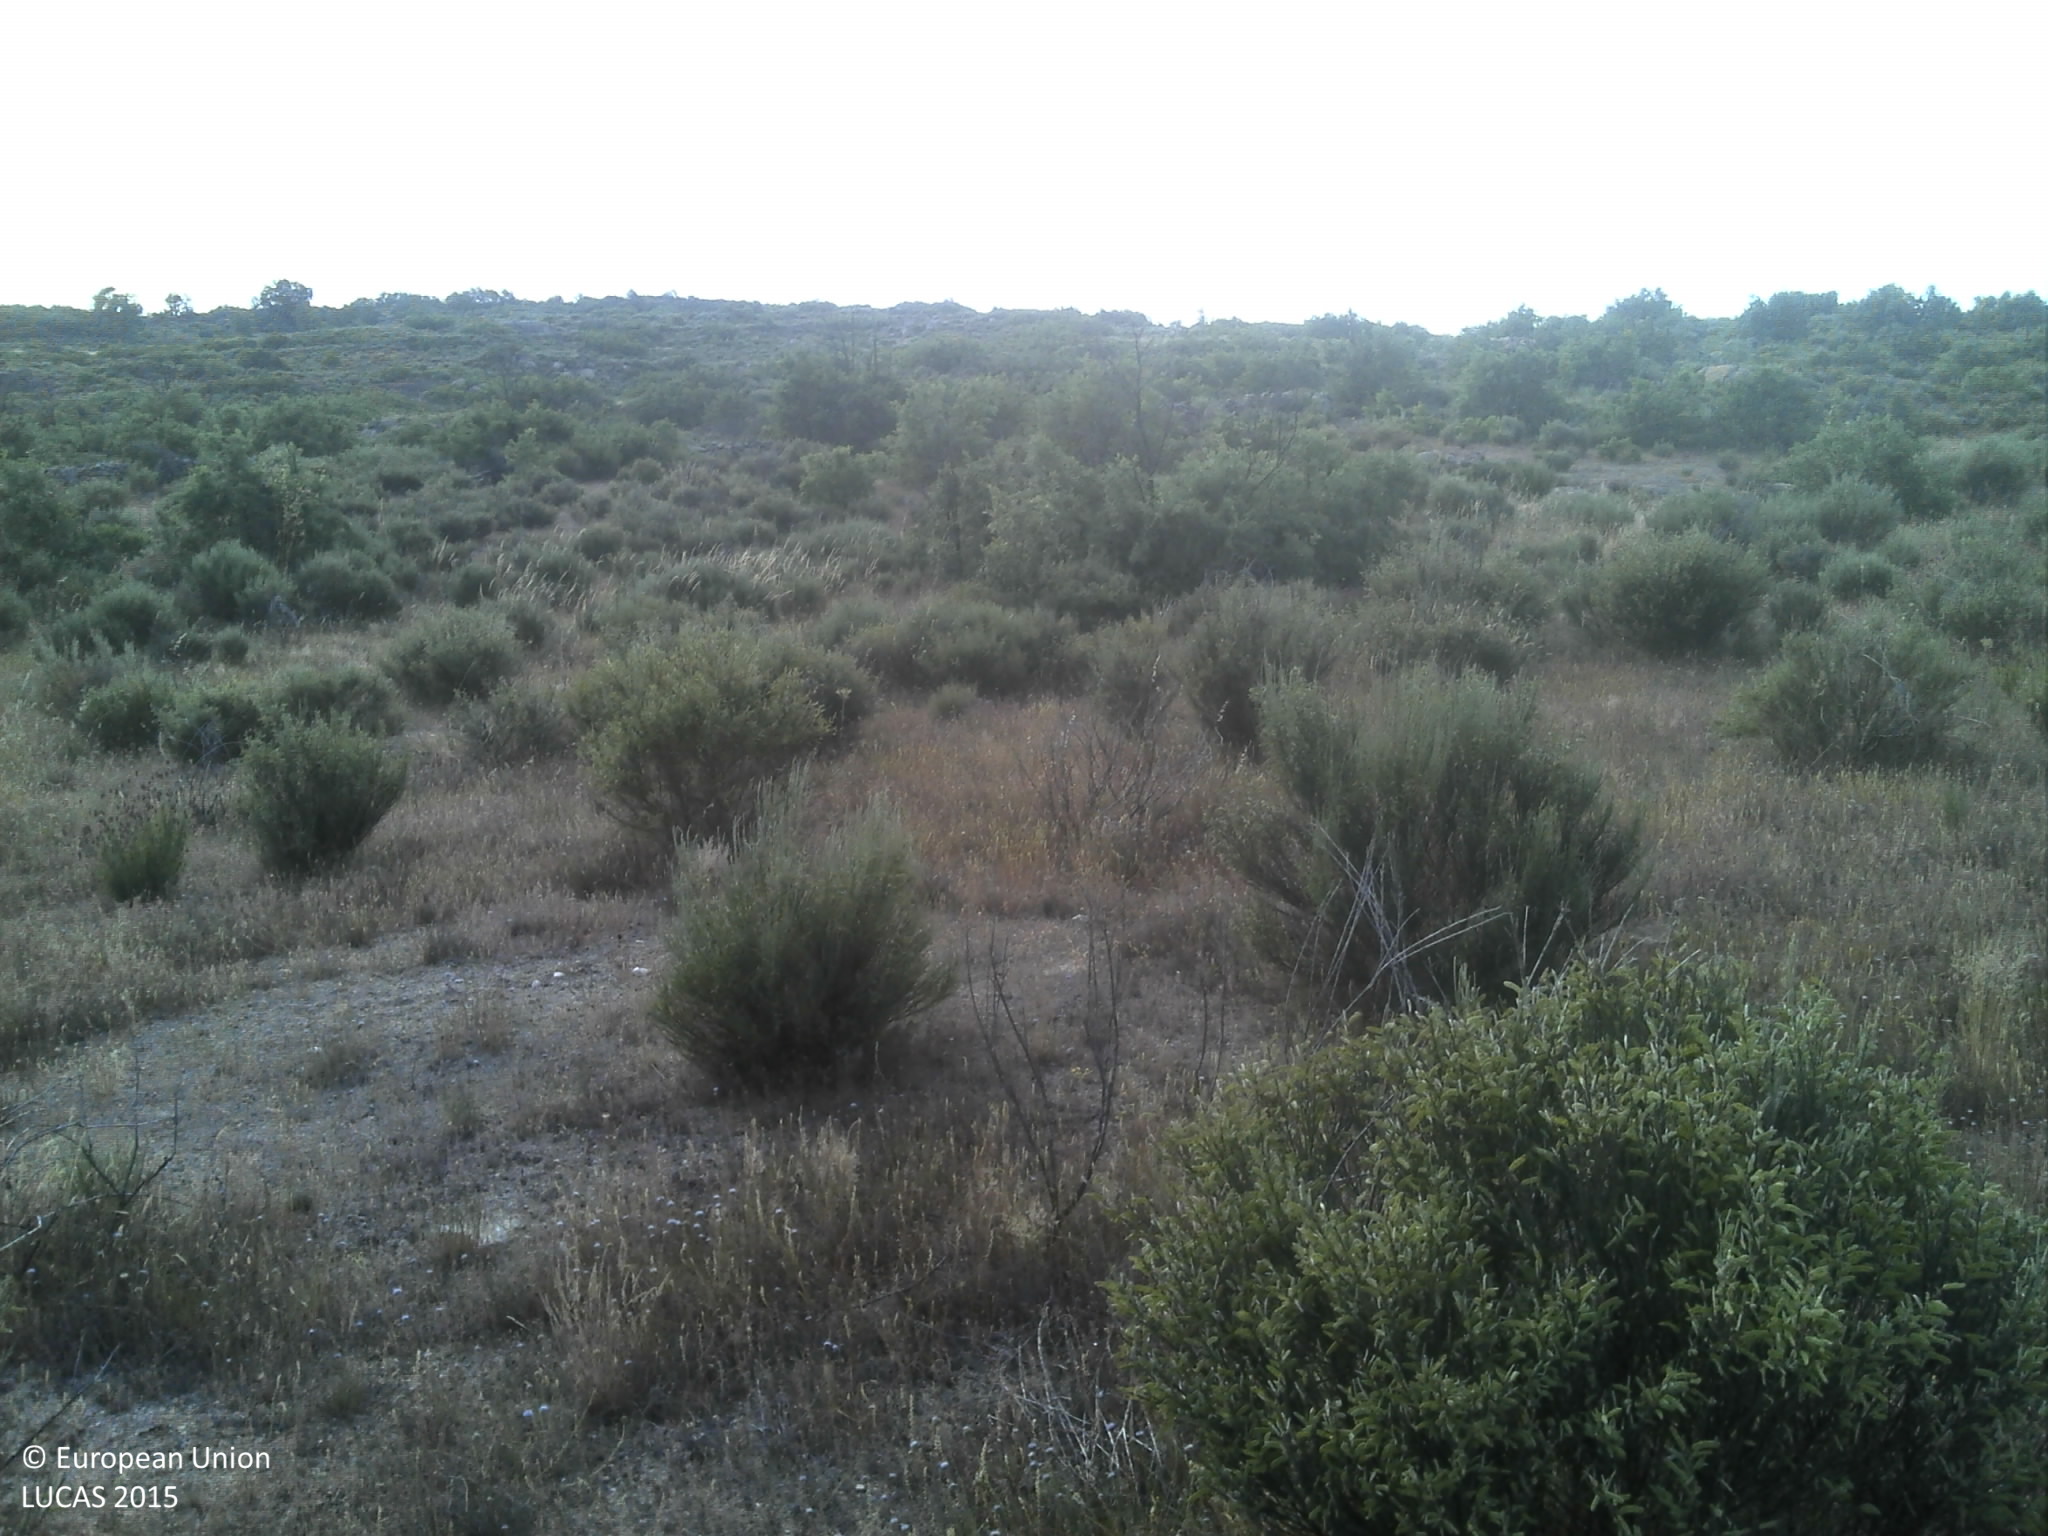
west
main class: Shrubland
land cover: Shrubland without tree cover
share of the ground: 50 - 75 %
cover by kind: shrubs 65 %, unconsolidated bare surface 15 %, herbaceous plants 10 %, consolidated bare surface 10 %
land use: Semi-natural and natural areas not in use
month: June
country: PT
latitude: 40.4948
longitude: -7.0550
